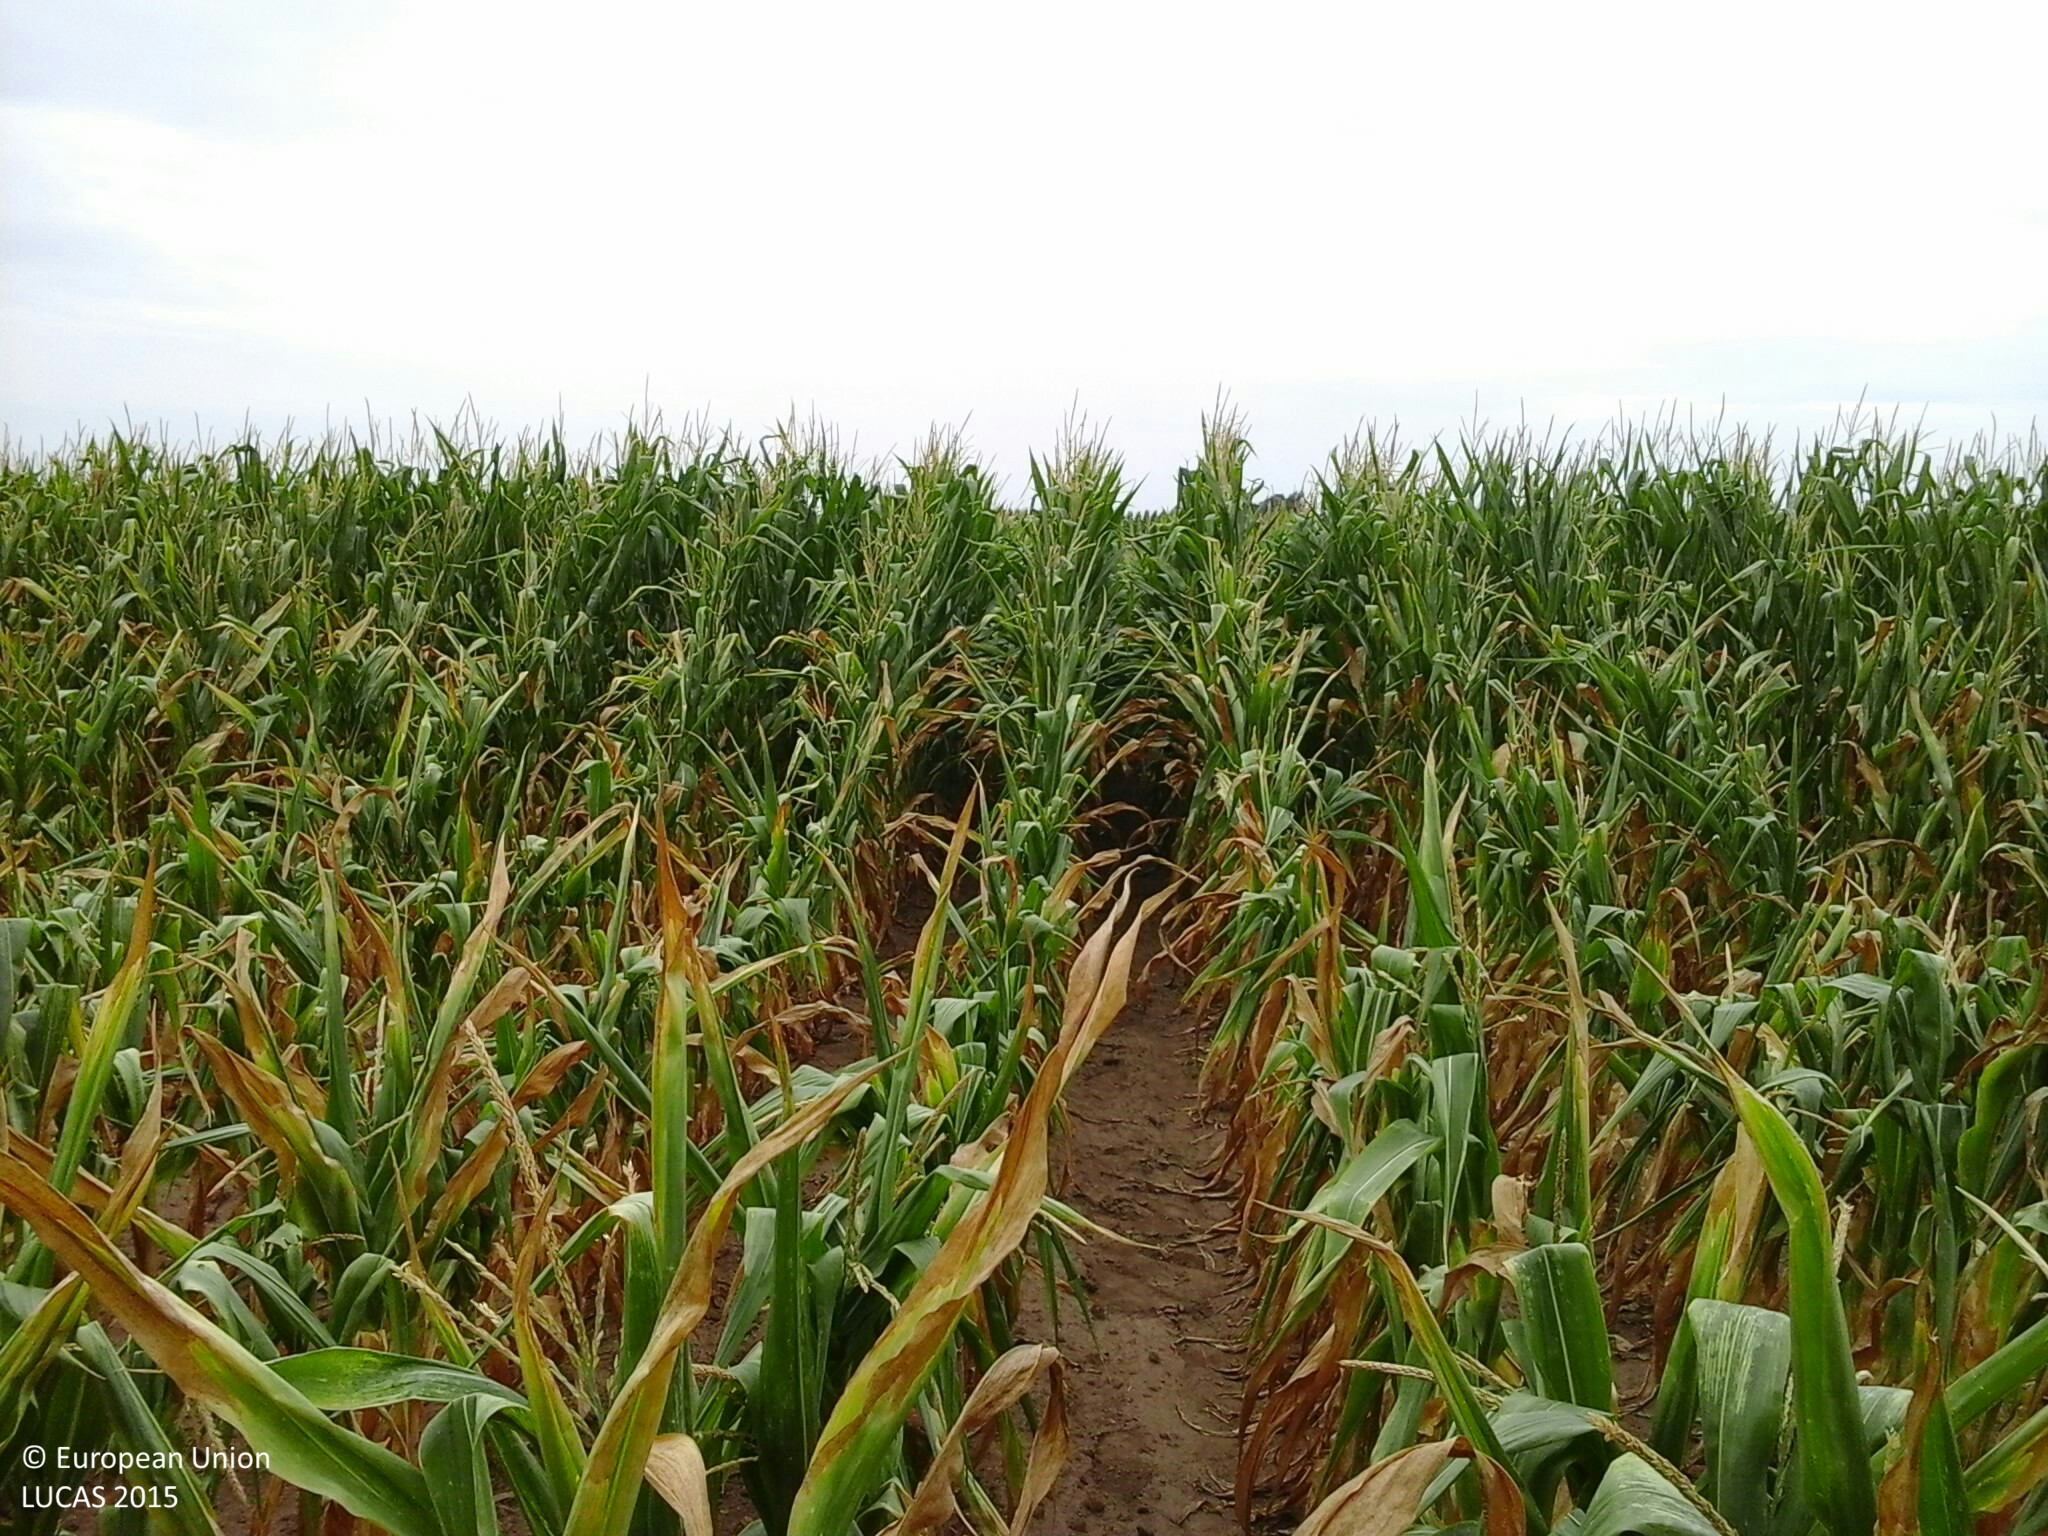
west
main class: Cropland
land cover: Maize
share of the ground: > 75 %
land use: Agriculture (excluding fallow land and kitchen gardens)
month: July
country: HU
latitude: 47.8792
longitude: 21.4498
